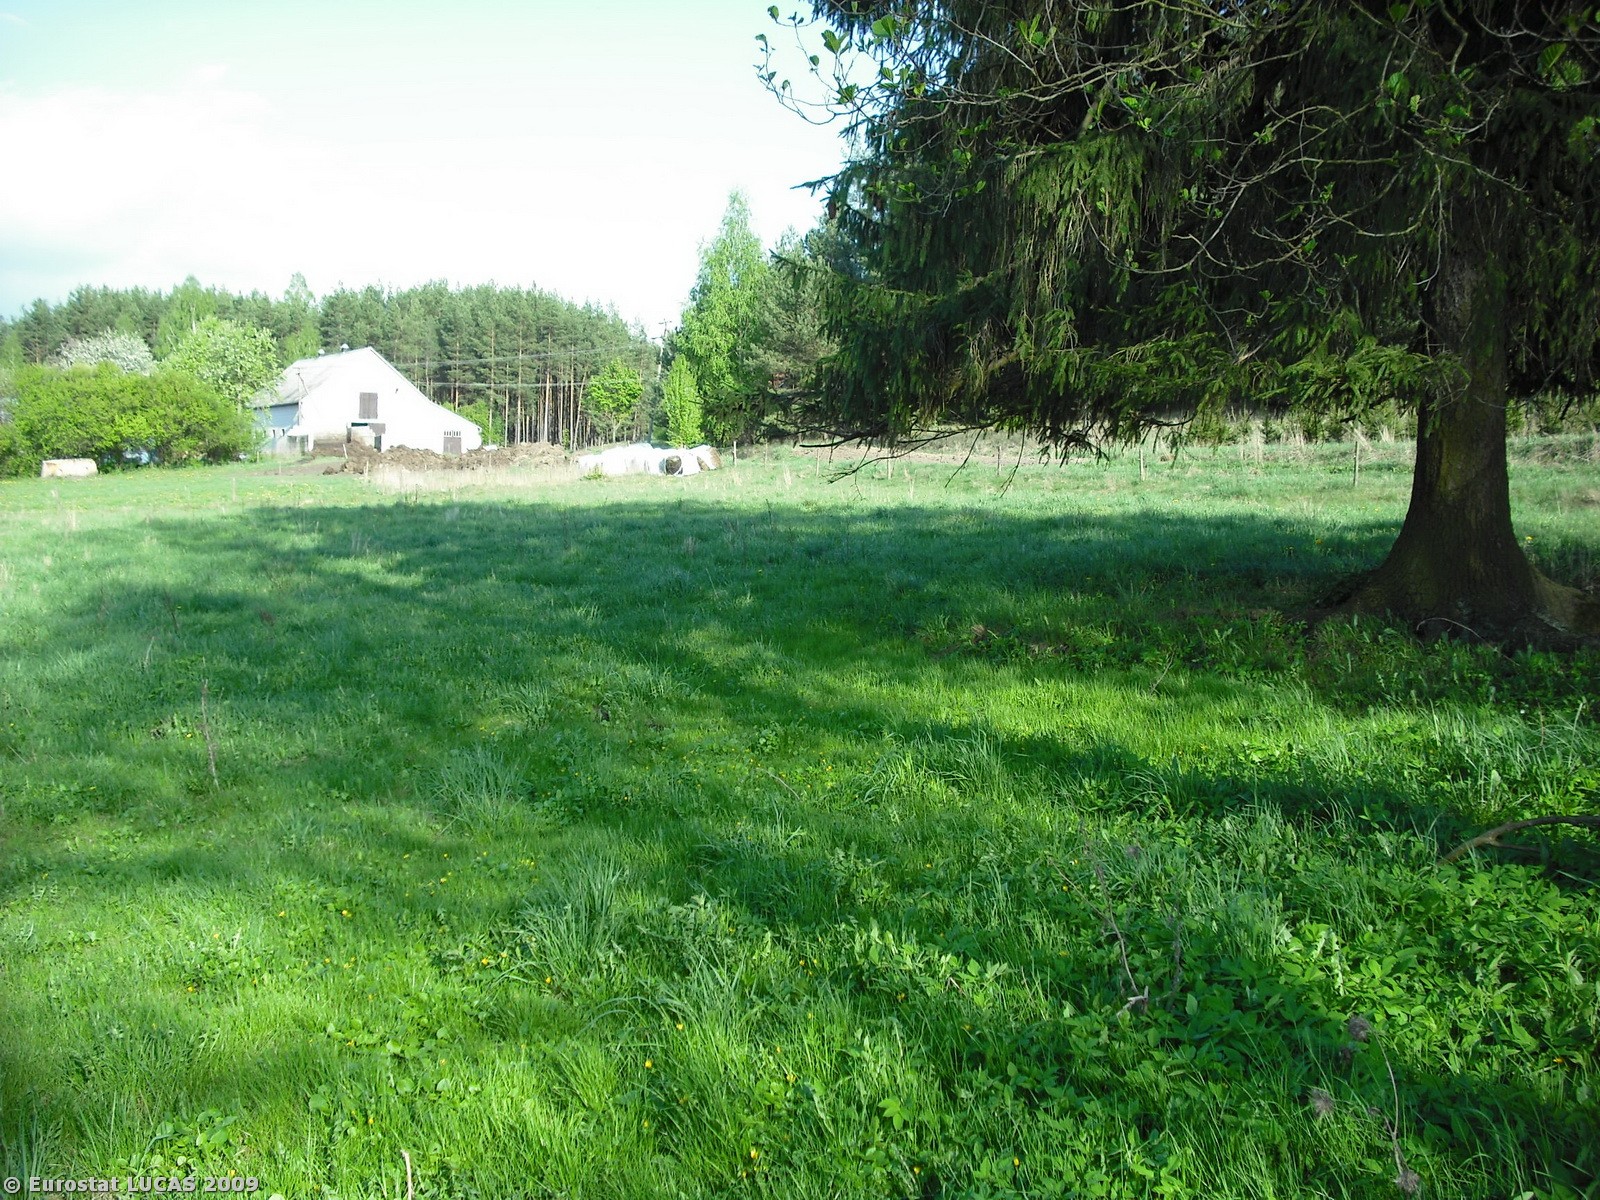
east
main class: Grassland
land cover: Grassland without tree/shrub cover
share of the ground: 50 - 75 %
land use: Agriculture (excluding fallow land and kitchen gardens)
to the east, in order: Grassland without tree/shrub cover; Bare land; Grassland without tree/shrub cover; Artificial constructions in urban areas; Shrubland with sparse tree cover; Tracks; Grassland with sparse tree/shrub cover; Coniferous woodland
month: August
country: PL
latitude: 53.0335
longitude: 23.5811
